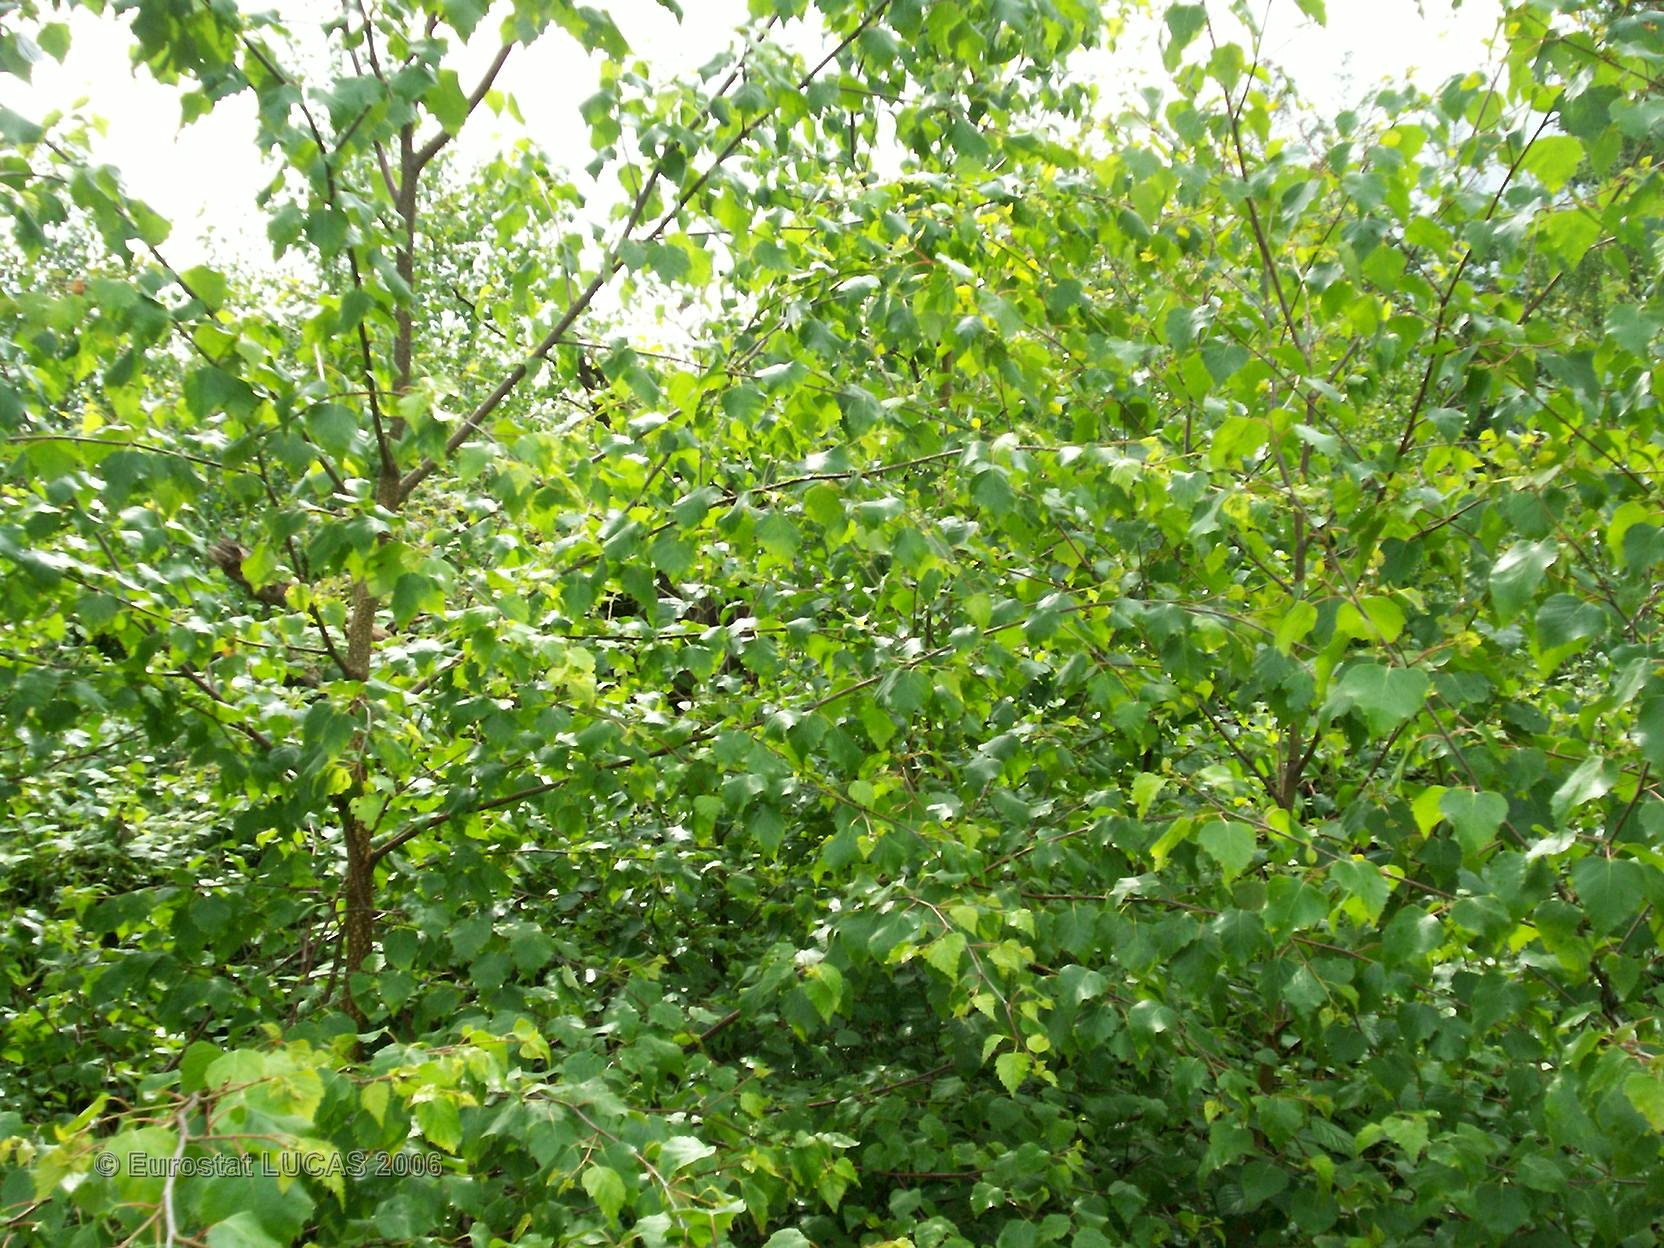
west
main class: Woodland
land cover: Broadleaved forest
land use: Forestry
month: May
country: FR
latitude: 48.5236
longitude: 6.9542
